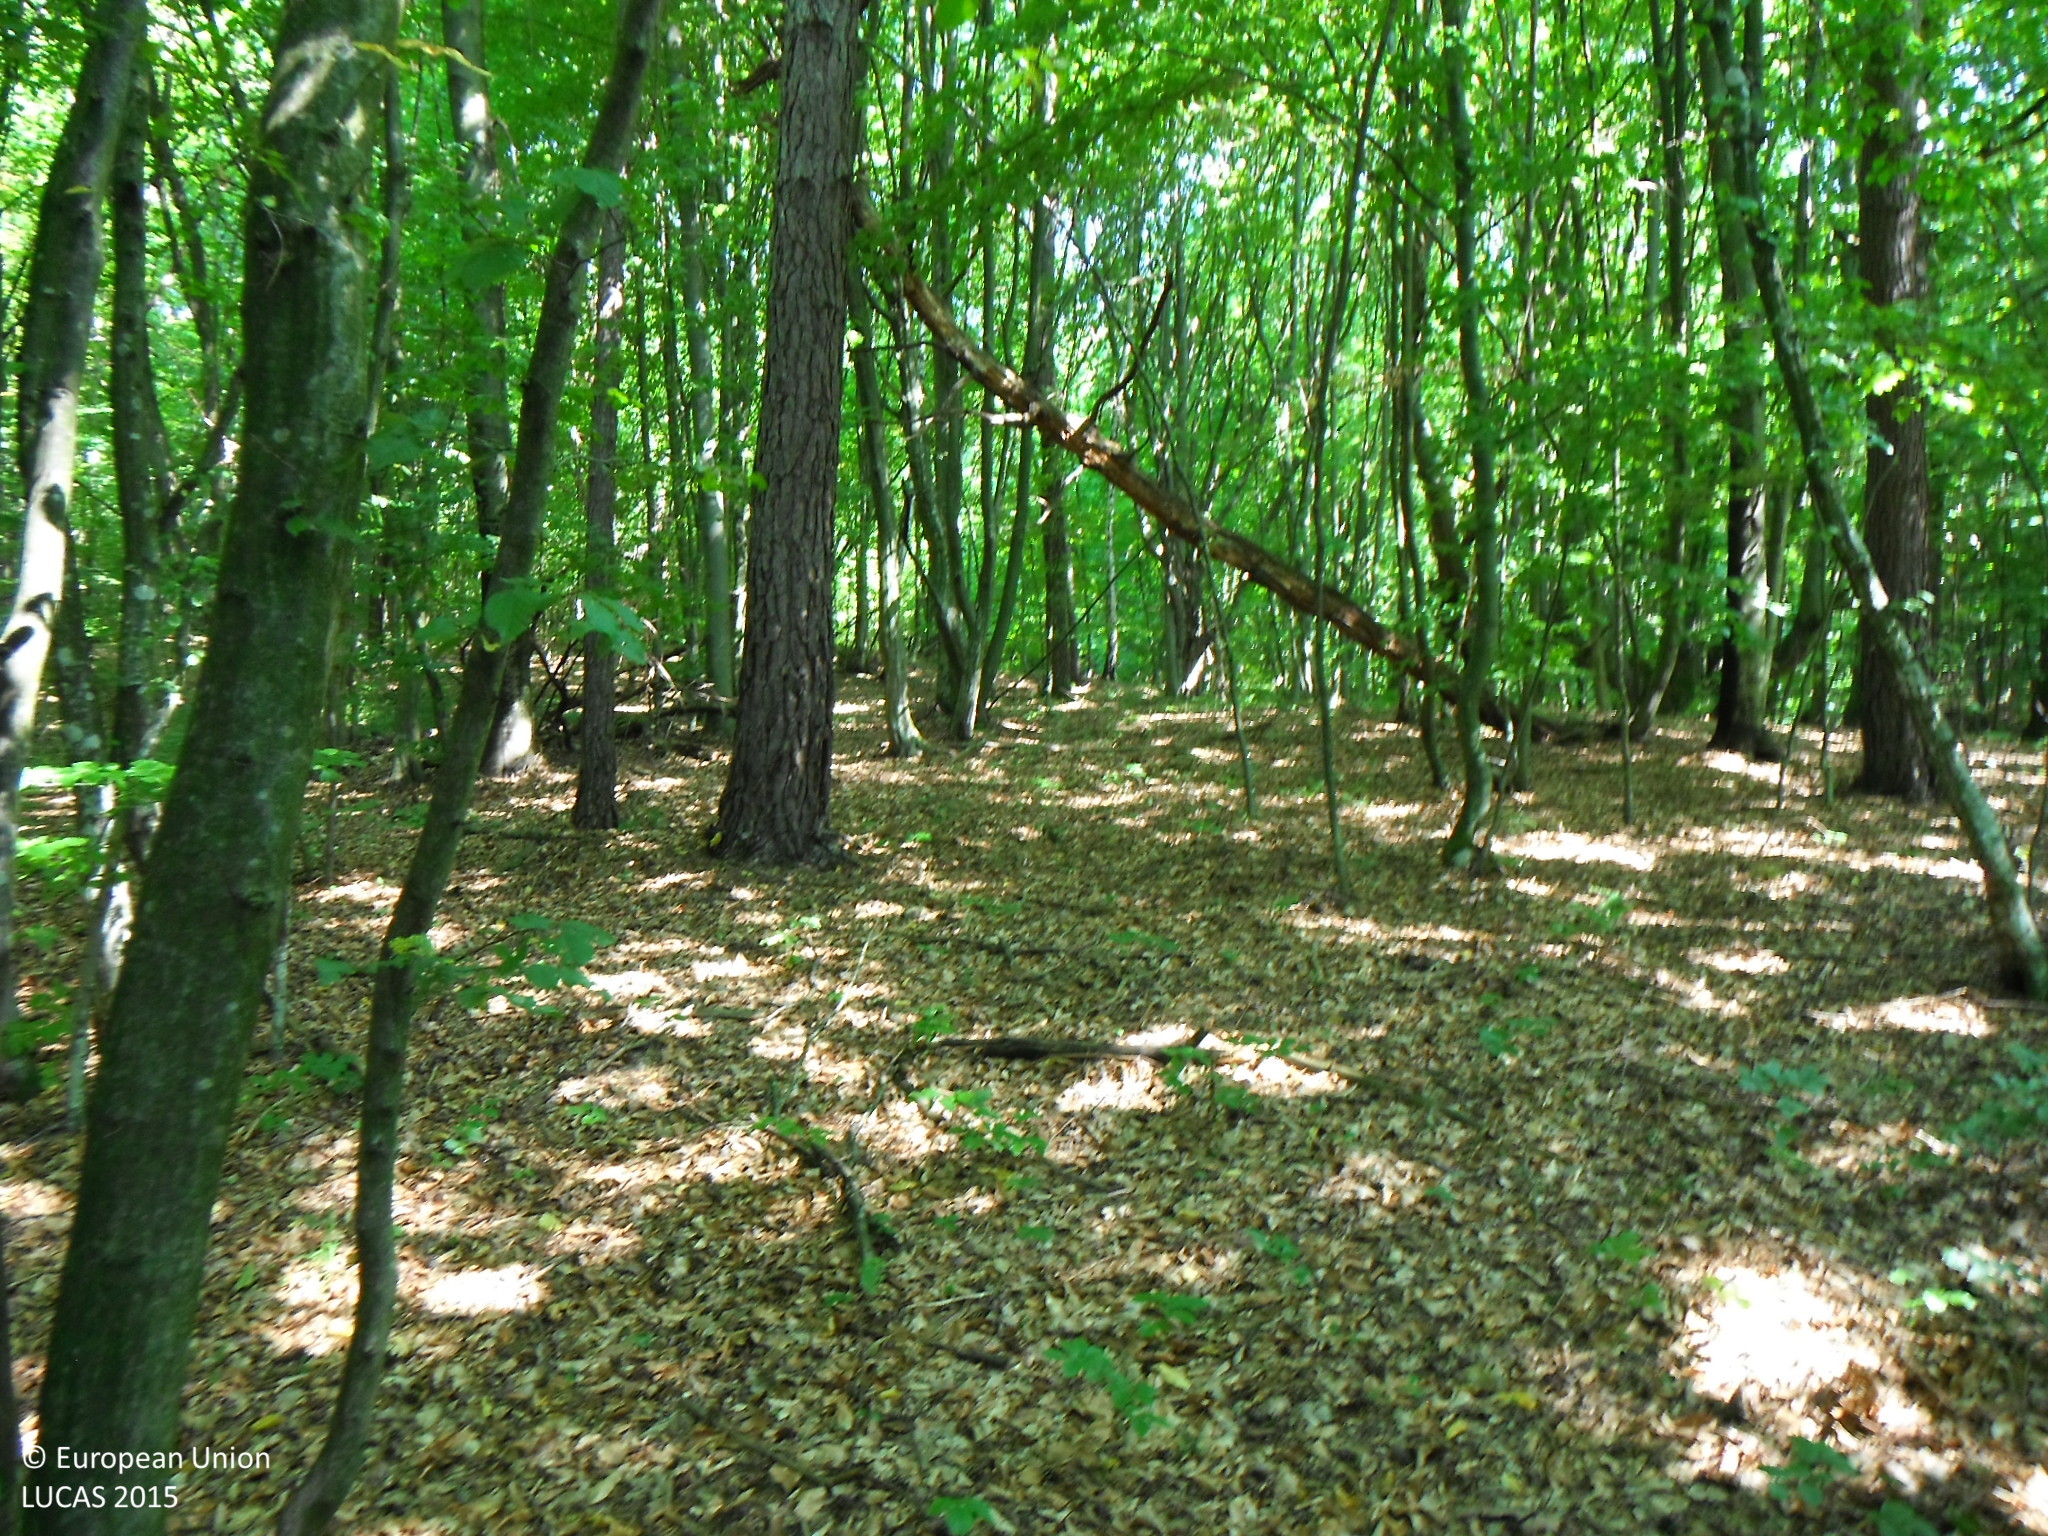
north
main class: Woodland
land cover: Broadleaved woodland
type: hemiboreal forest and nemoral coniferous forest and mixed broadleaved-coniferous forest
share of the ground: > 75 %
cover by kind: broadleaved forest trees 85 %, coniferous forest trees 15 %
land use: Forestry
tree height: > 5 m
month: August
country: SK
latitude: 49.1155
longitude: 21.9611
